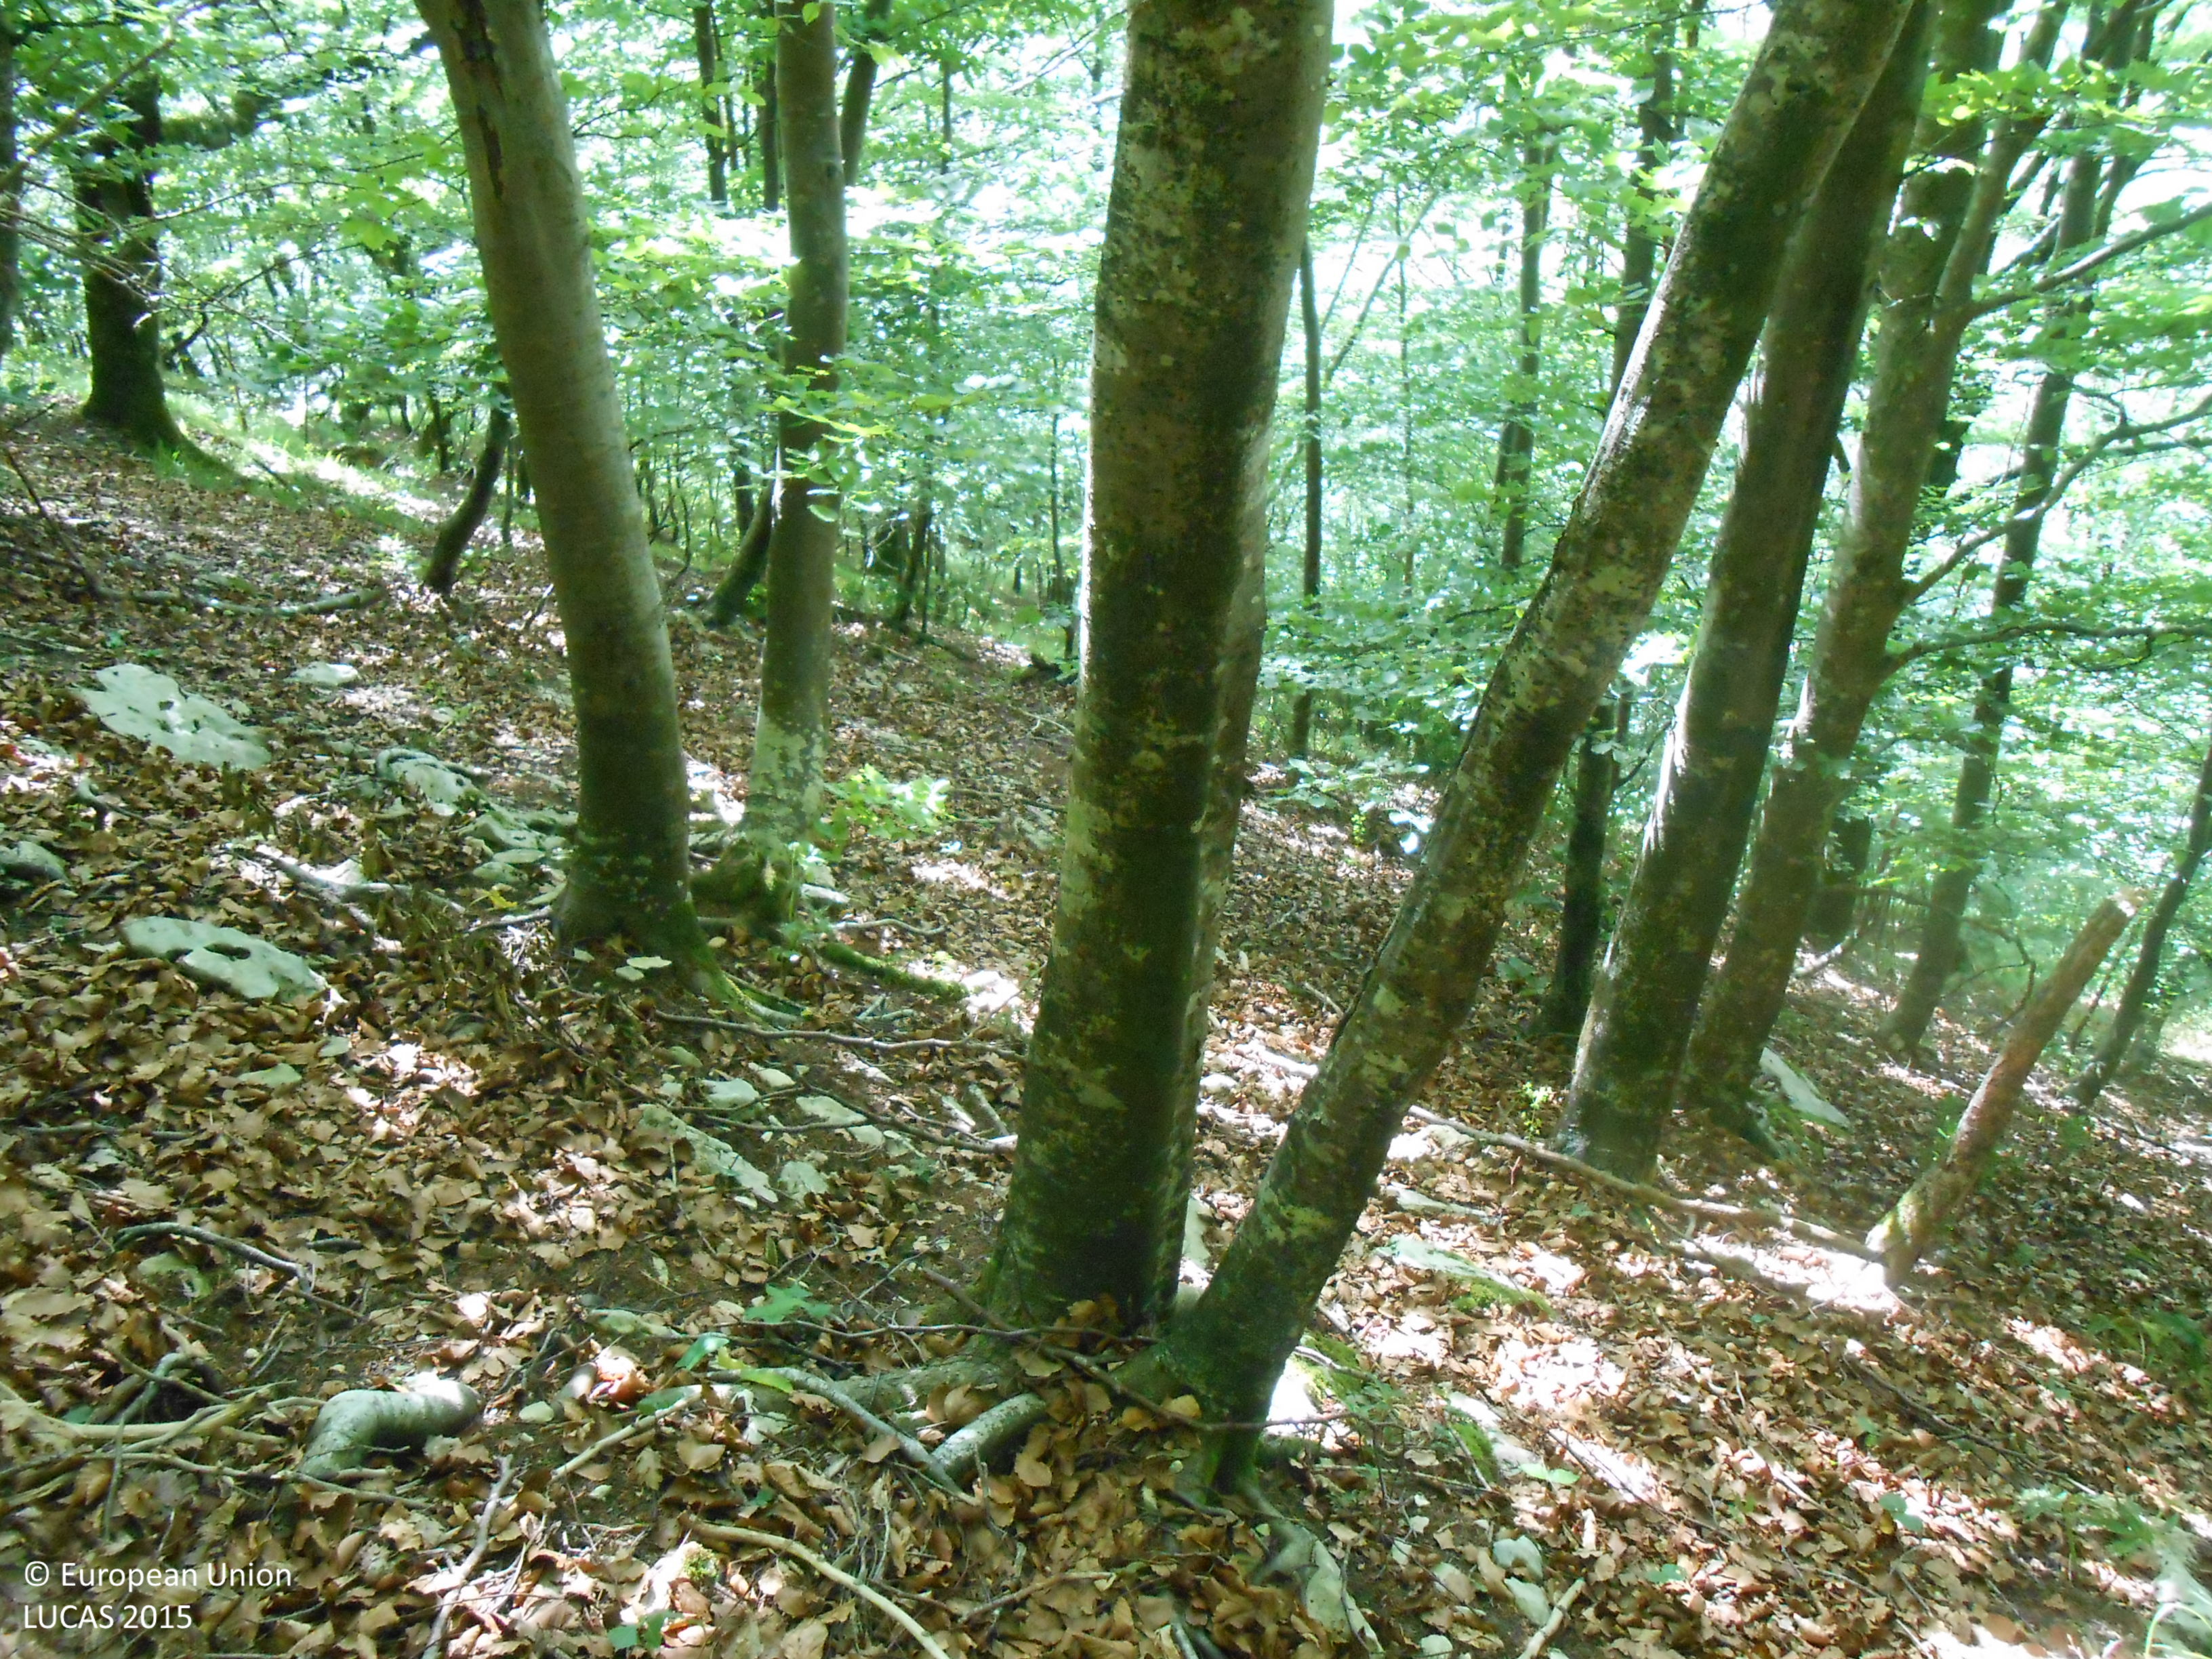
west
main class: Woodland
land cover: Broadleaved woodland
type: beech forest
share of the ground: > 75 %
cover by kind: broadleaved forest trees 100 %
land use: Forestry
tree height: > 5 m
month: June
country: ES
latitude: 43.0768
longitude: -1.7721
